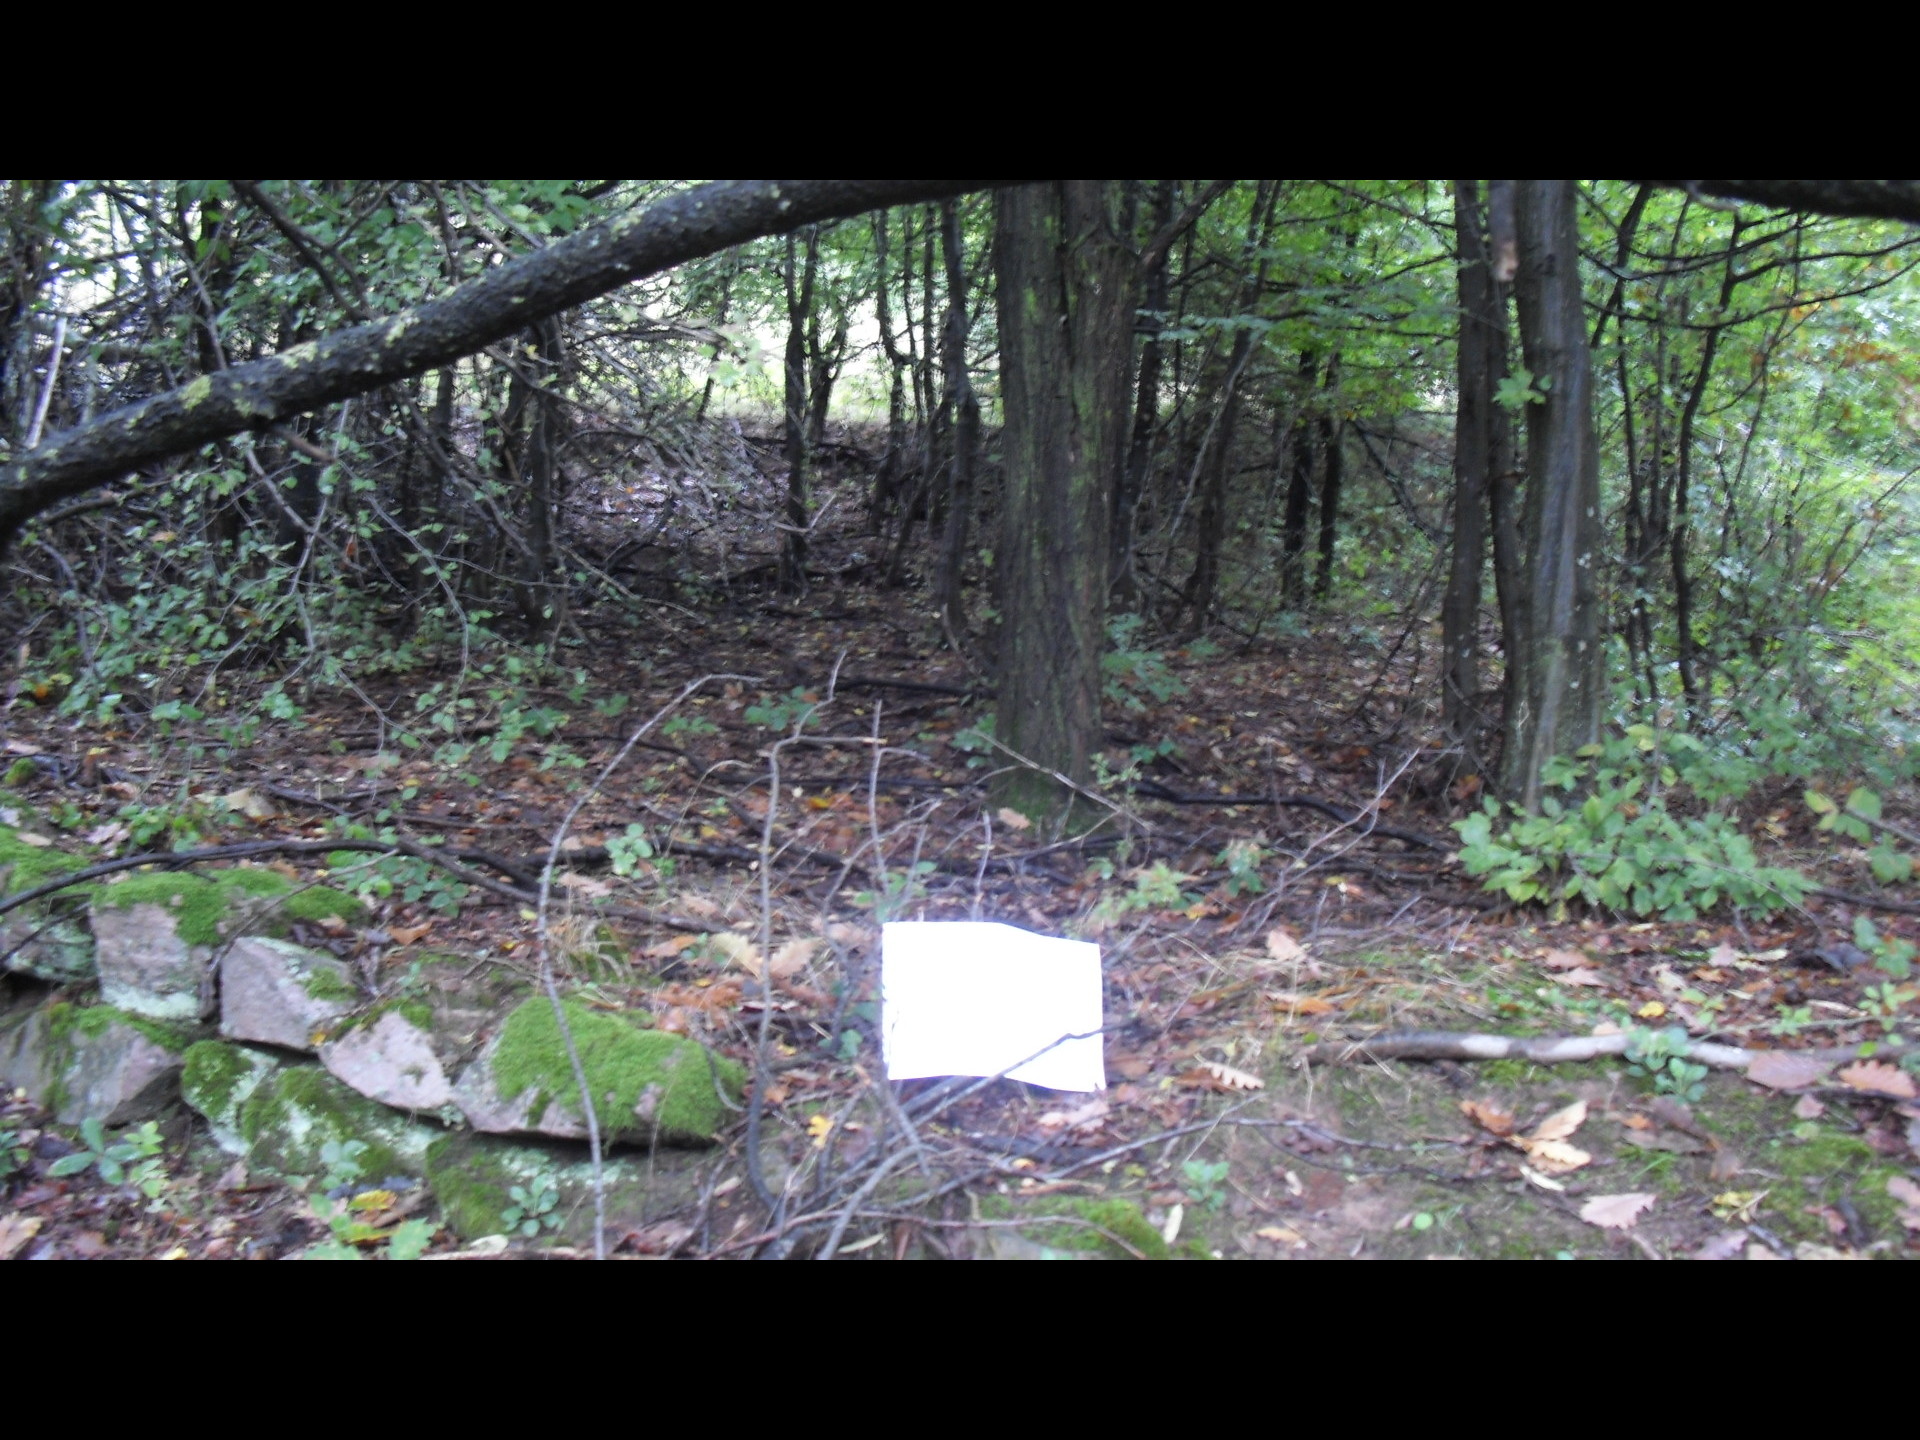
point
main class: Woodland
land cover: Broadleaved woodland
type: mesophytic deciduous forest
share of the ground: > 75 %
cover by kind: broadleaved forest trees 90 %, unconsolidated bare surface 10 %
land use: Forestry
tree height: > 5 m
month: October
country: BG
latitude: 43.4566
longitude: 22.8506
